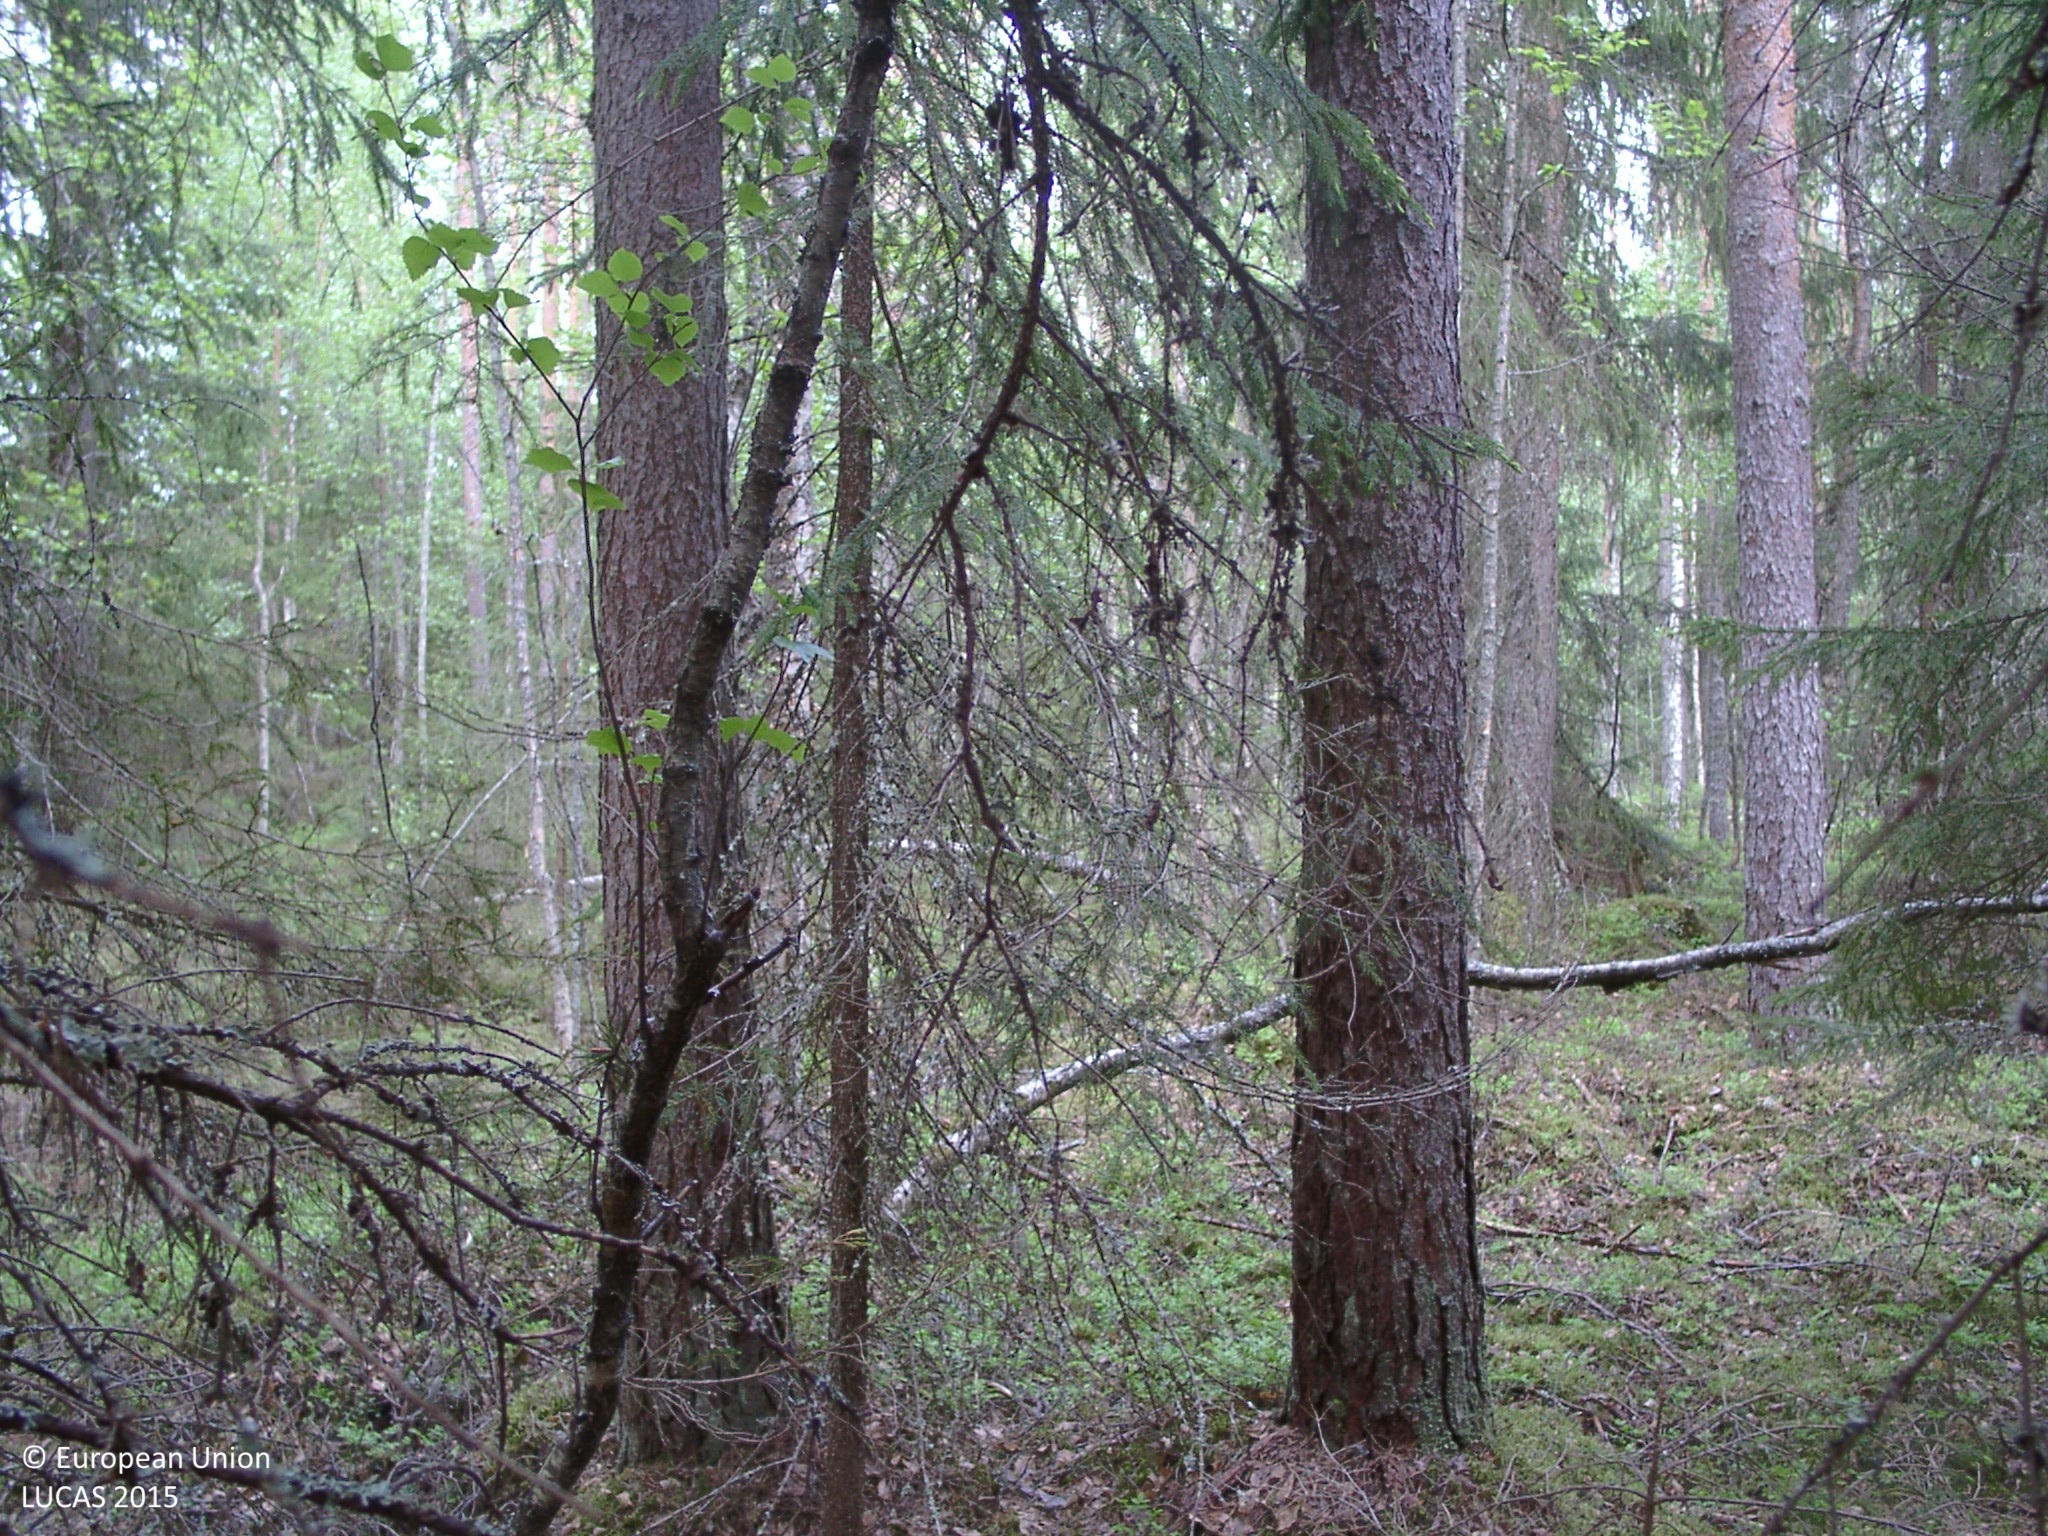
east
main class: Woodland
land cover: Other coniferous woodland
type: boreal forest
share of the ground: > 75 %
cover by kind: coniferous forest trees 70 %, lichens and mosses 15 %, shrubs 10 %, broadleaved forest trees 5 %
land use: Semi-natural and natural areas not in use
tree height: > 5 m
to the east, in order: Other coniferous woodland; Ditches and canals; Other mixed woodland; Ditches and canals; Other mixed woodland; Ditches and canals; Other mixed woodland; Shruby margins; Pine dominated coniferous woodland; Grass margins; Pine dominated coniferous woodland; Grass margins; Pine dominated coniferous woodland; Shruby margins; Pine dominated coniferous woodland; Shruby margins; Other coniferous woodland
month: June
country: FI
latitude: 62.1230
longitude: 25.4315
